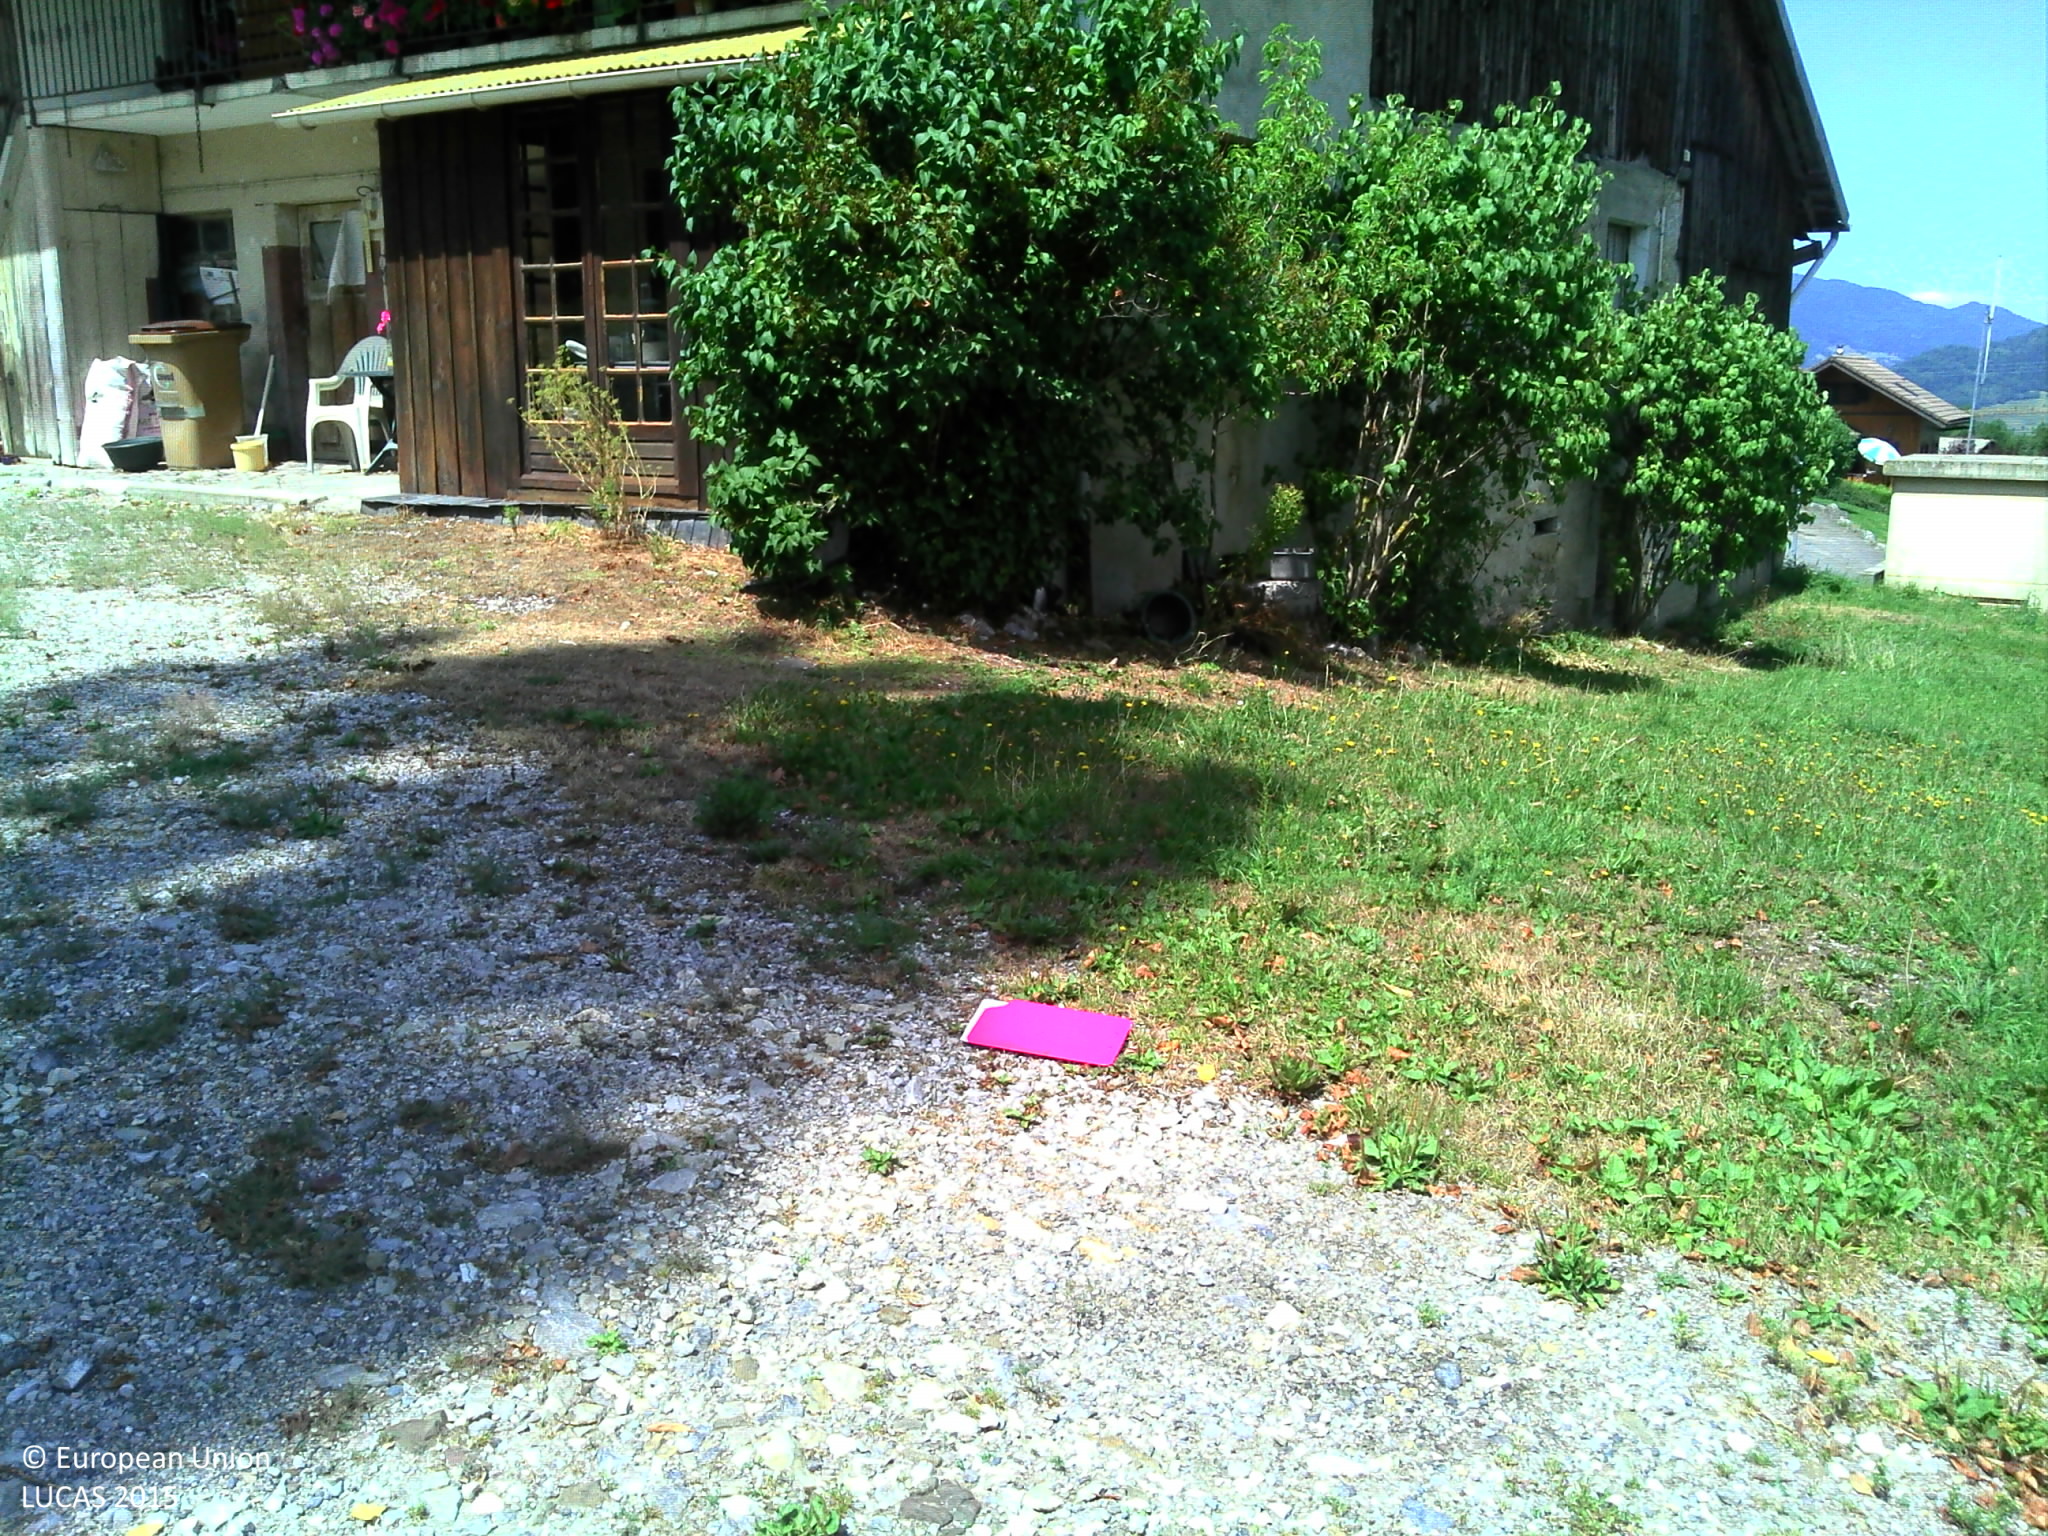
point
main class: Grassland
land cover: Grassland without tree/shrub cover
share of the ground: > 75 %
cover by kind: herbaceous plants 100 %
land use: Residential
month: July
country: FR
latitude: 46.1101
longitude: 6.3939
